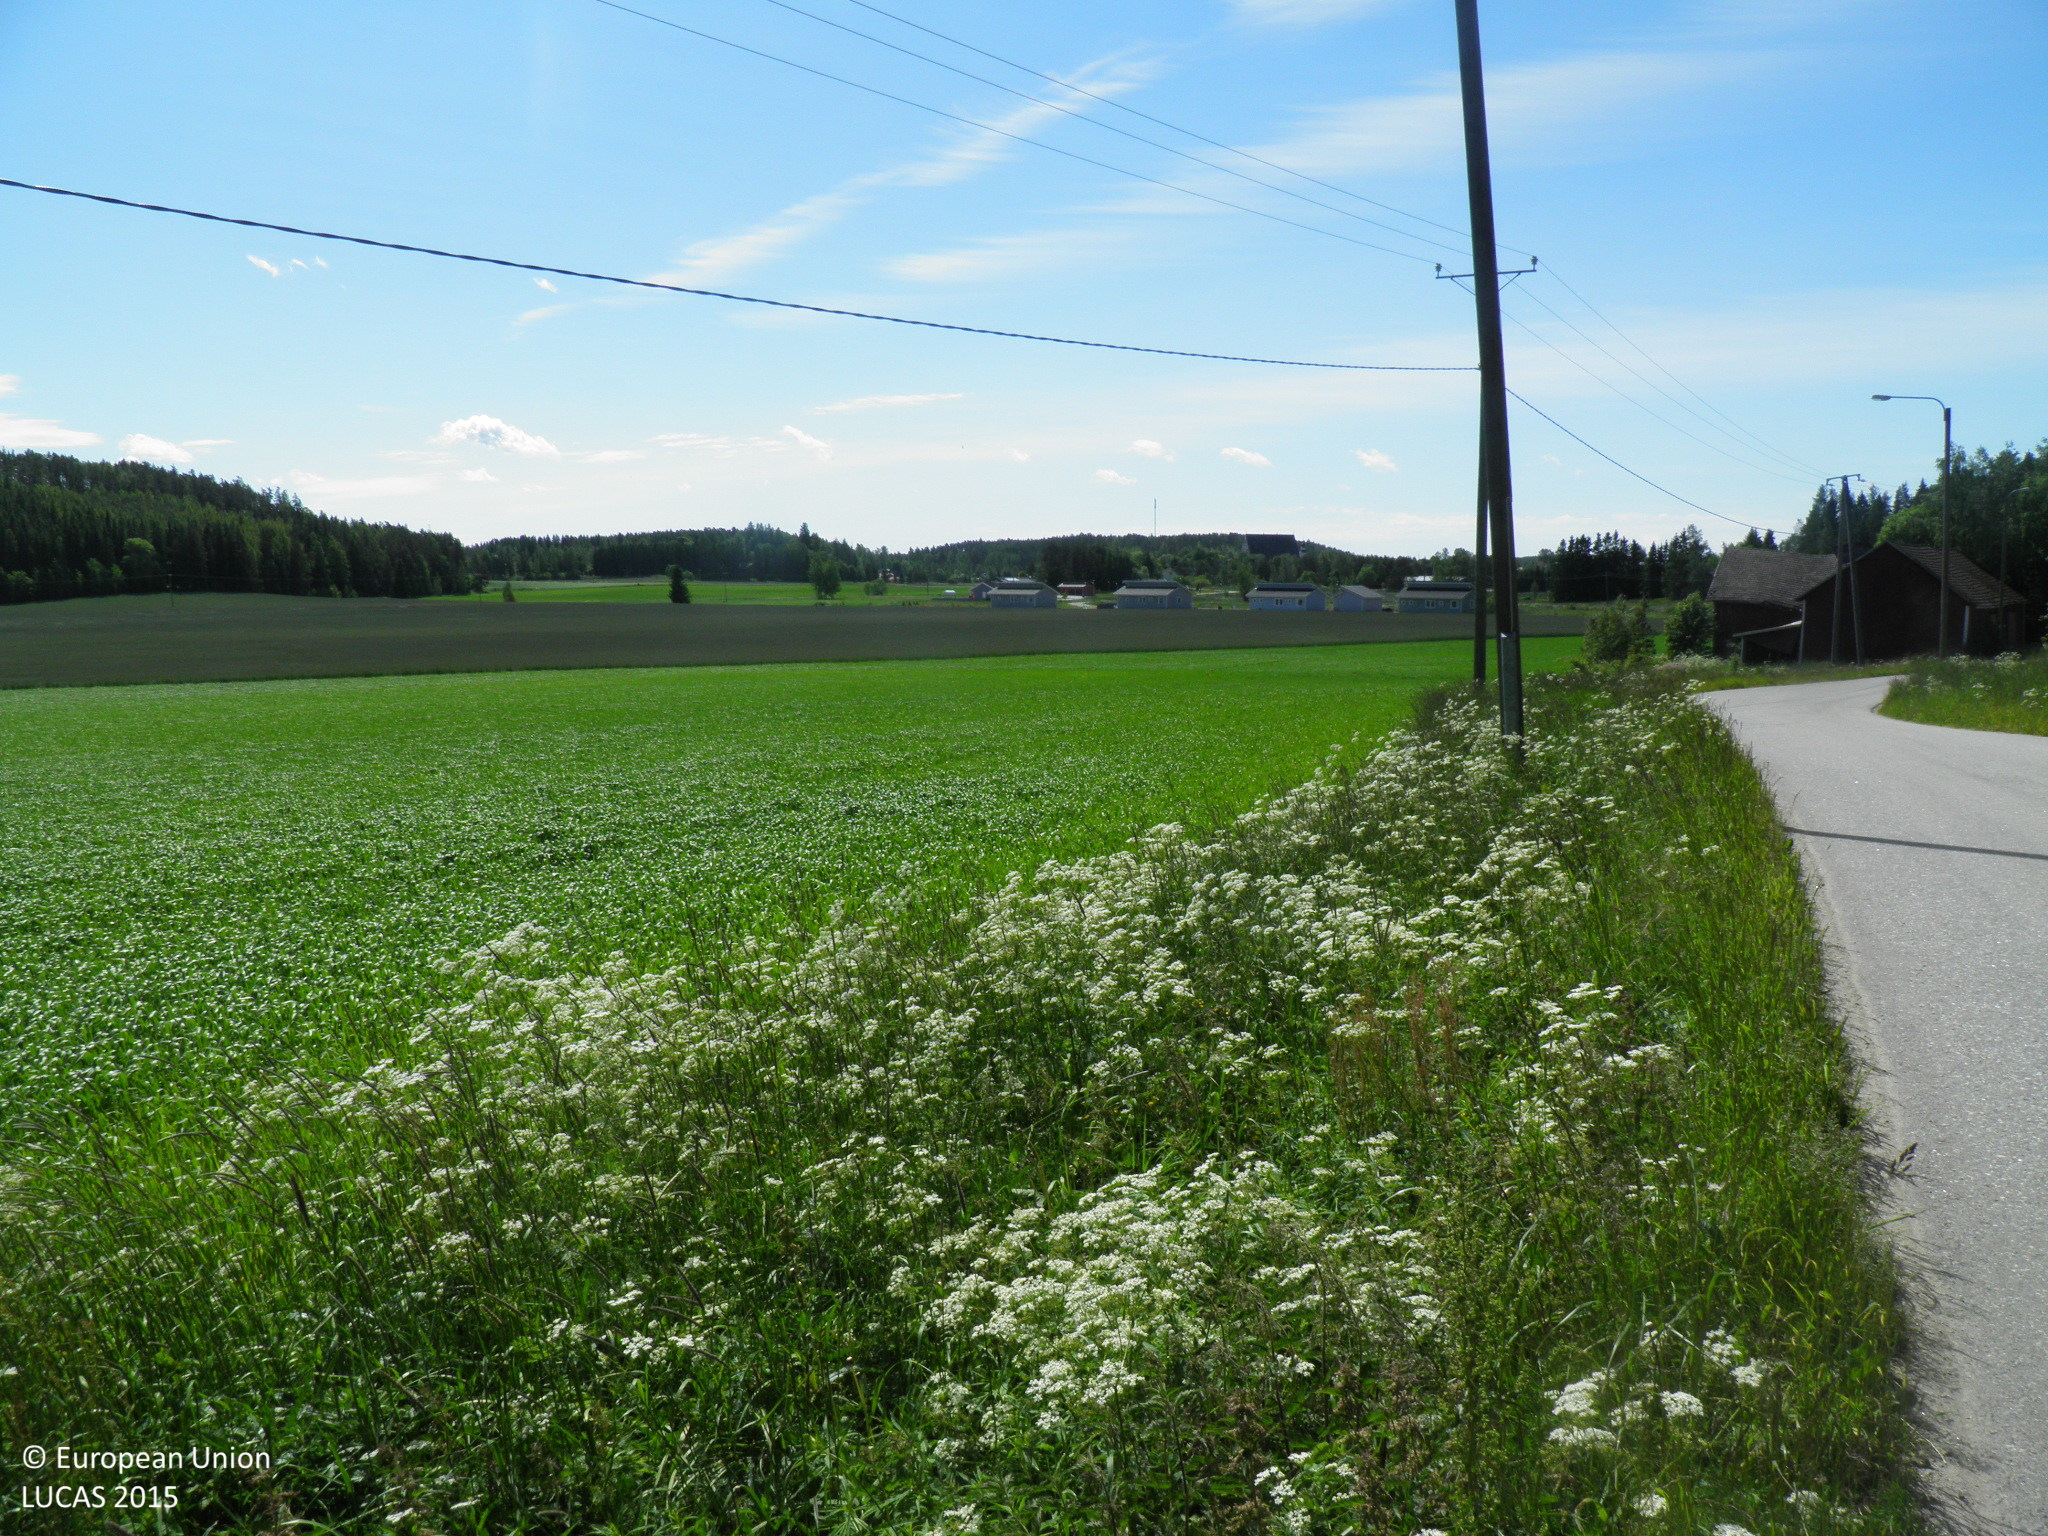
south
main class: Cropland
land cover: Common wheat
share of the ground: > 75 %
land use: Agriculture (excluding fallow land and kitchen gardens)
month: June
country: FI
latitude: 60.3522
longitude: 22.7061
